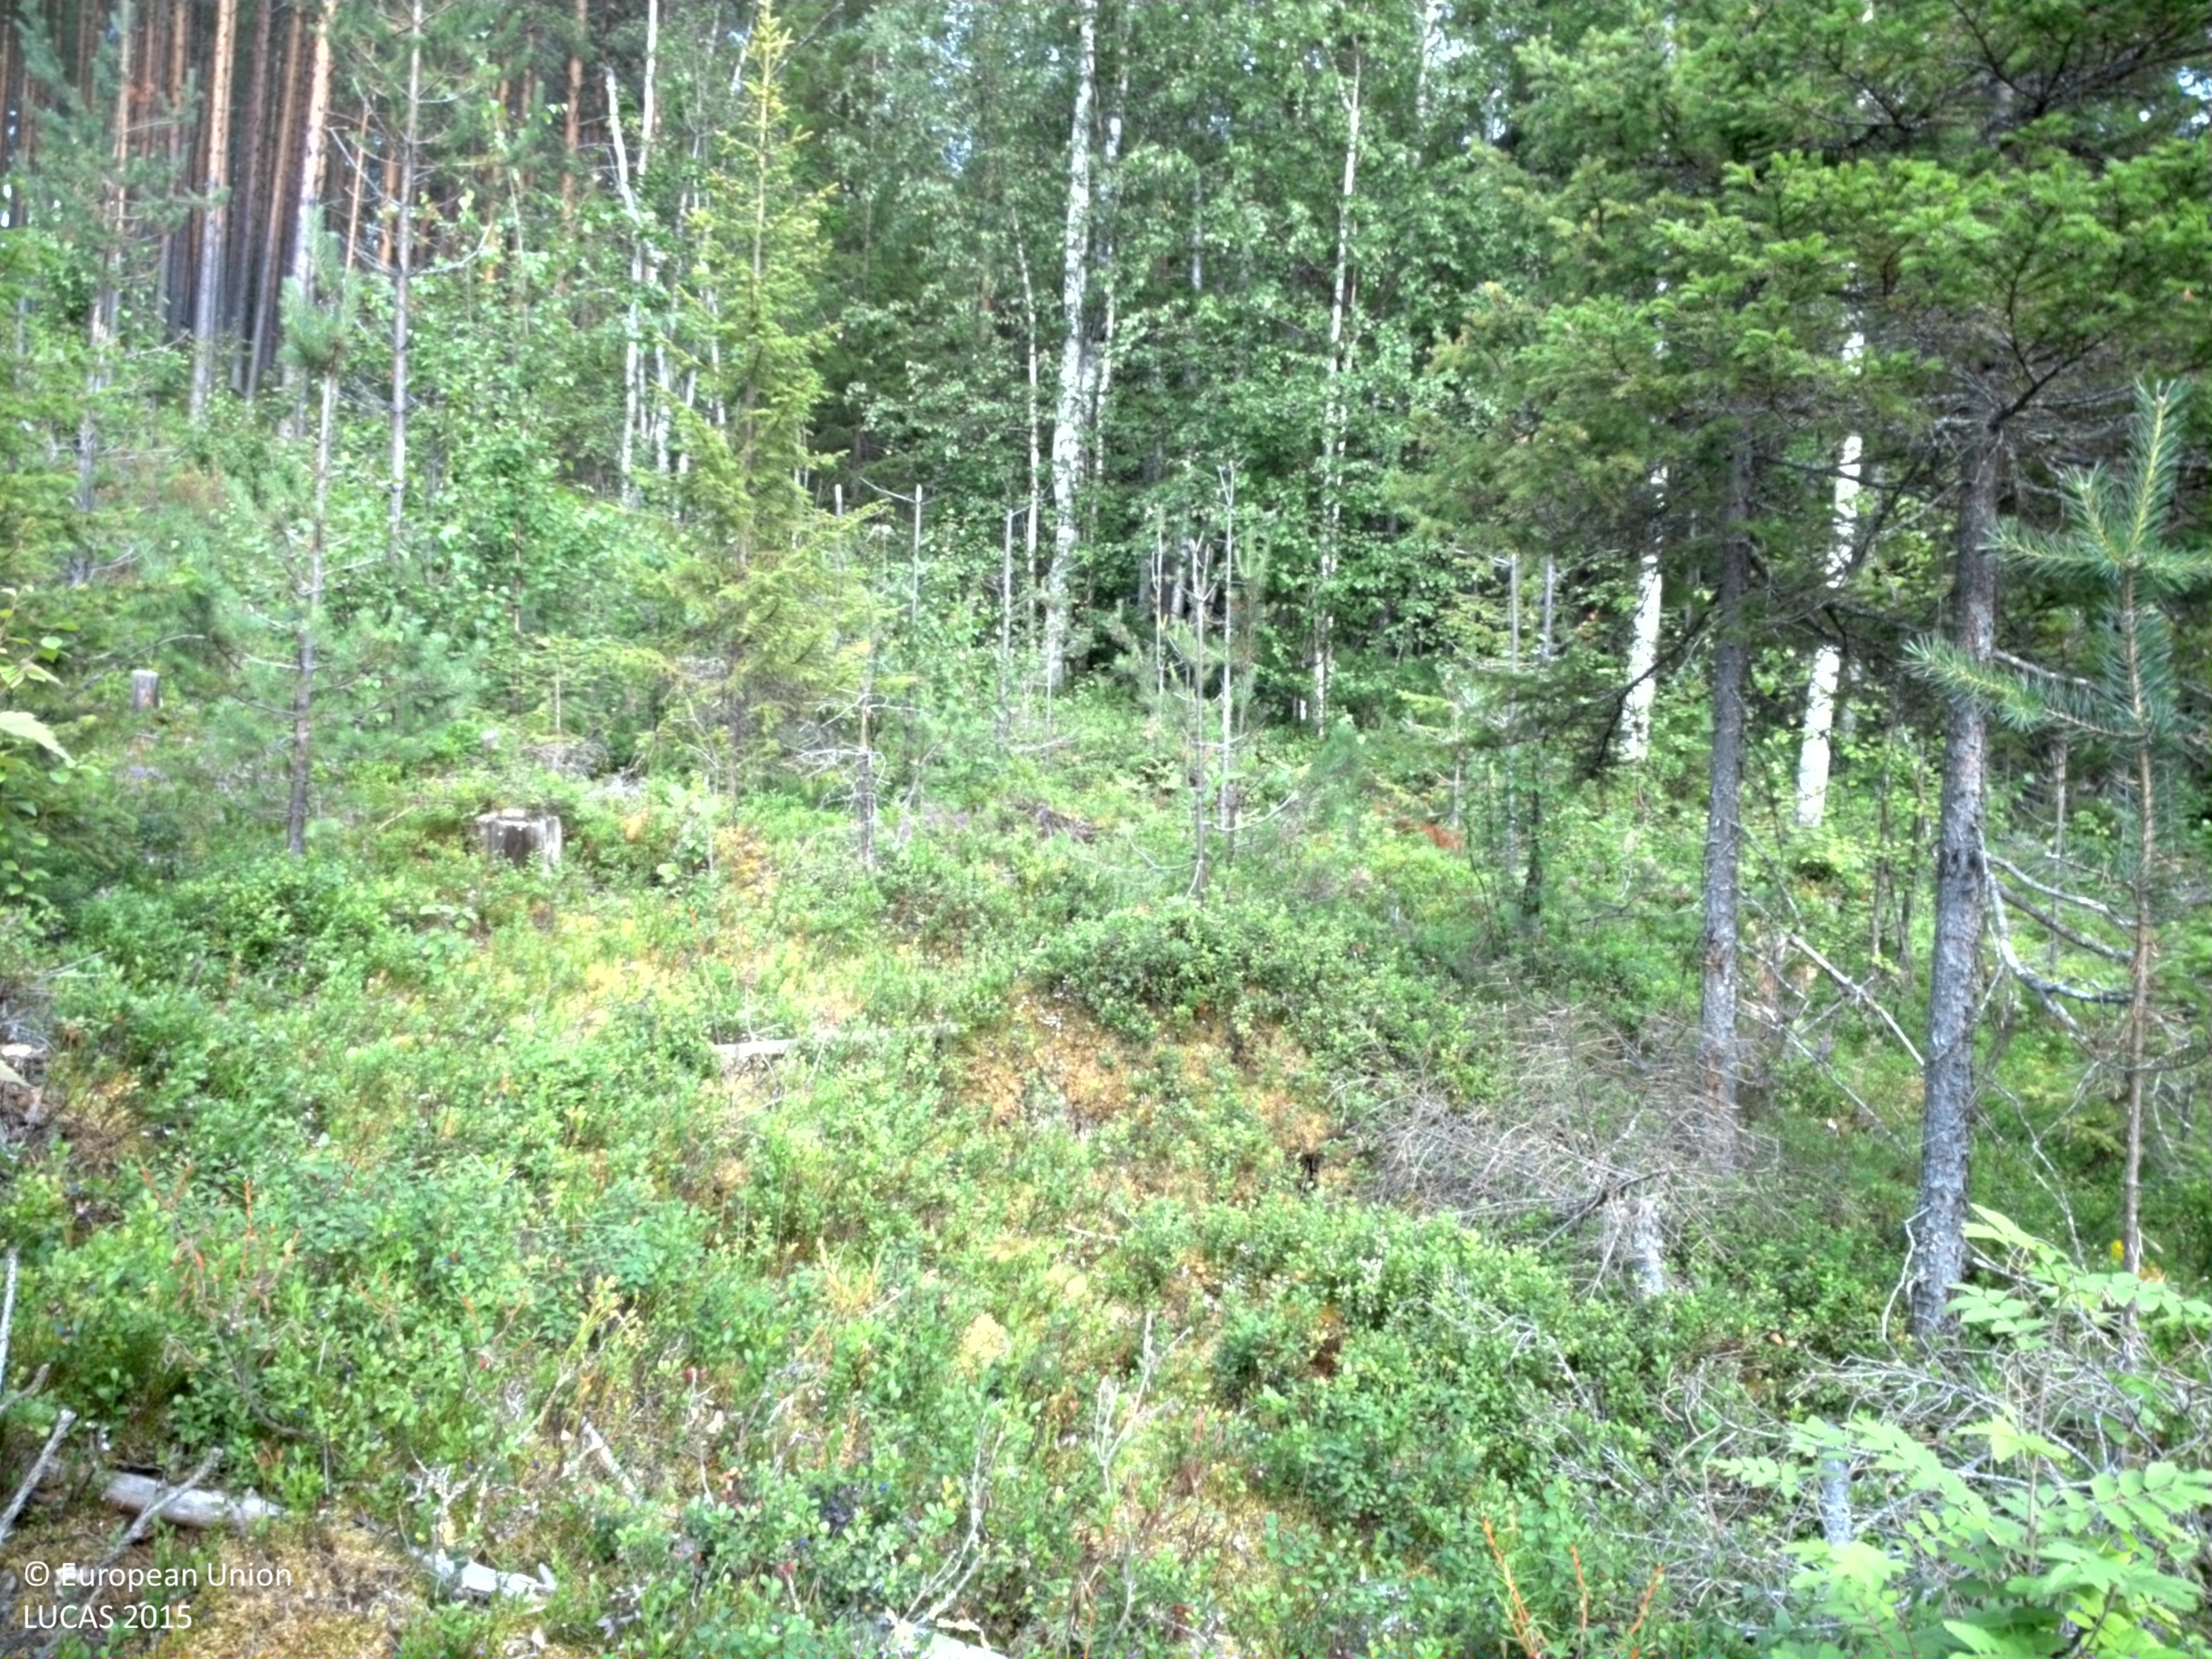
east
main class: Woodland
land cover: Pine dominated mixed woodland
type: boreal forest
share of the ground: 25 - 50 %
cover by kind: shrubs 70 %, broadleaved forest trees 15 %, coniferous forest trees 10 %, lichens and mosses 5 %
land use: Forestry
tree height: > 5 m
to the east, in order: Pine dominated mixed woodland; Spruce dominated mixed woodland; Broadleaved woodland; Pine dominated coniferous woodland; Broadleaved woodland; Pine dominated mixed woodland
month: August
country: SE
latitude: 66.3534
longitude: 20.7508
